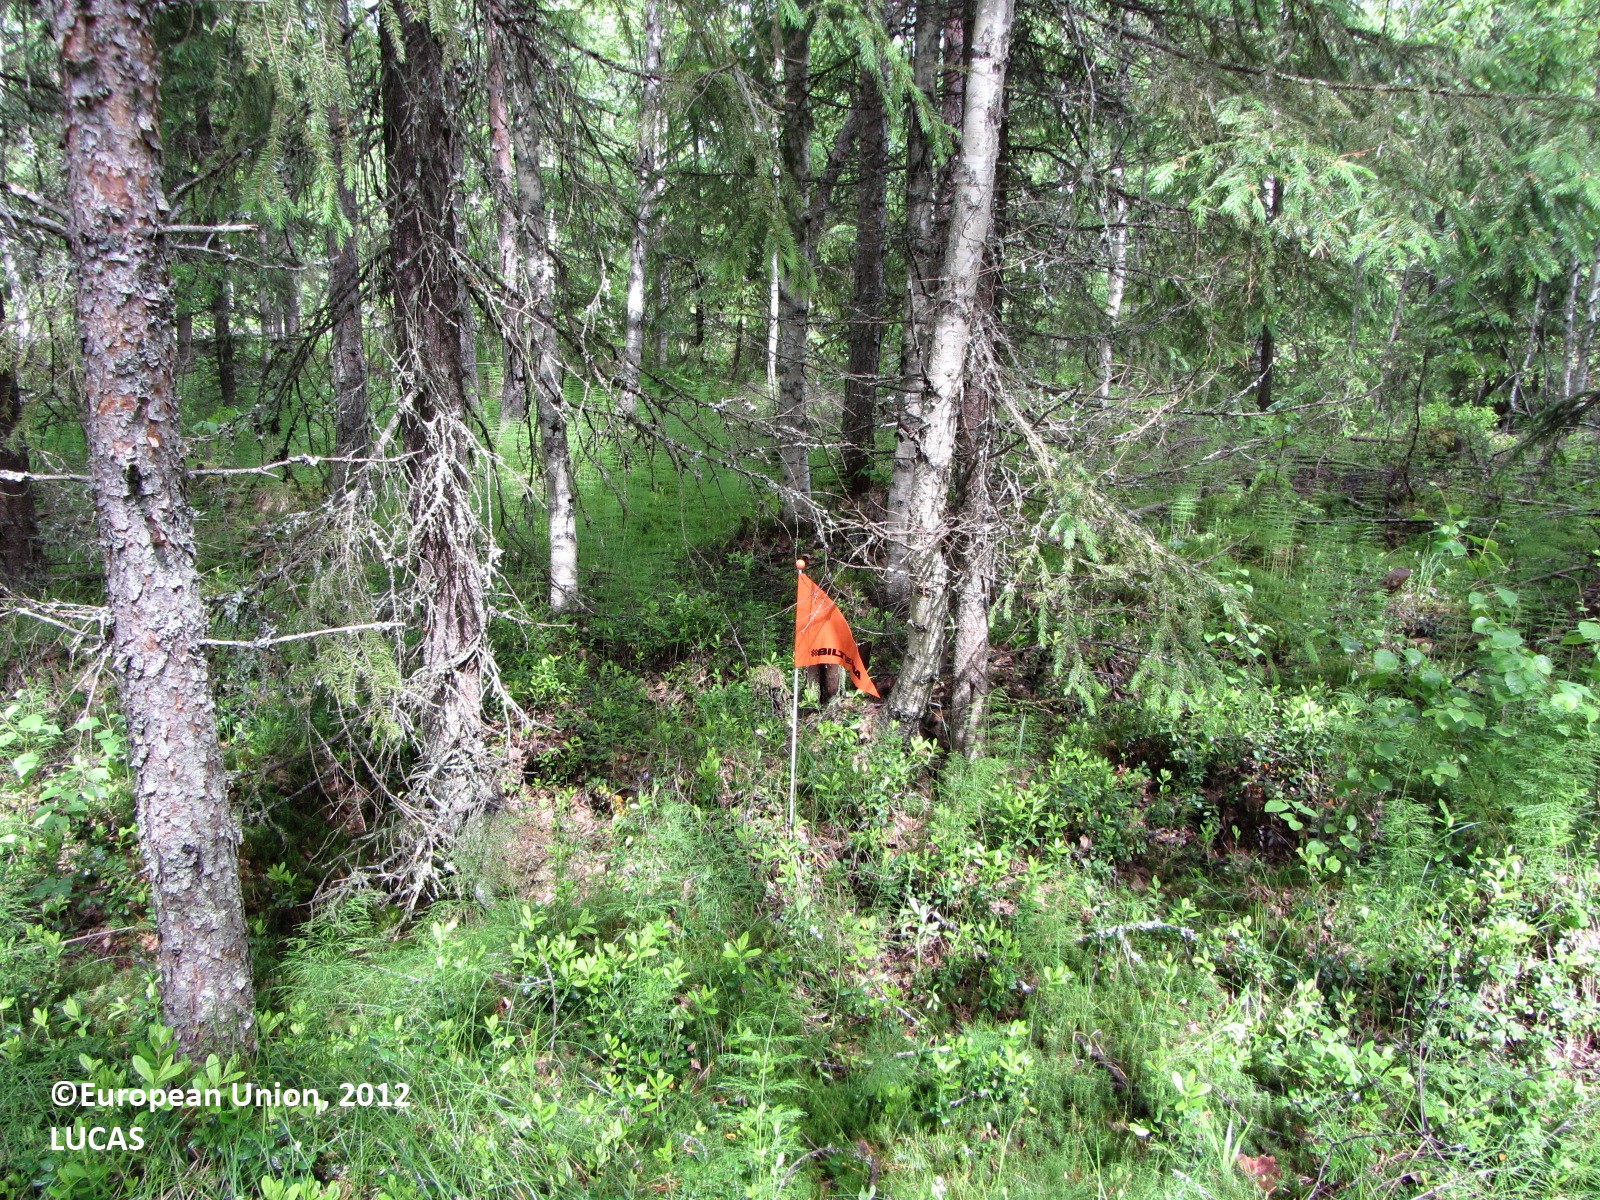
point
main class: Woodland
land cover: Other mixed woodland
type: boreal forest
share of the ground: > 75 %
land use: Forestry
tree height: > 5 m
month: June
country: FI
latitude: 62.6270
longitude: 25.0134
